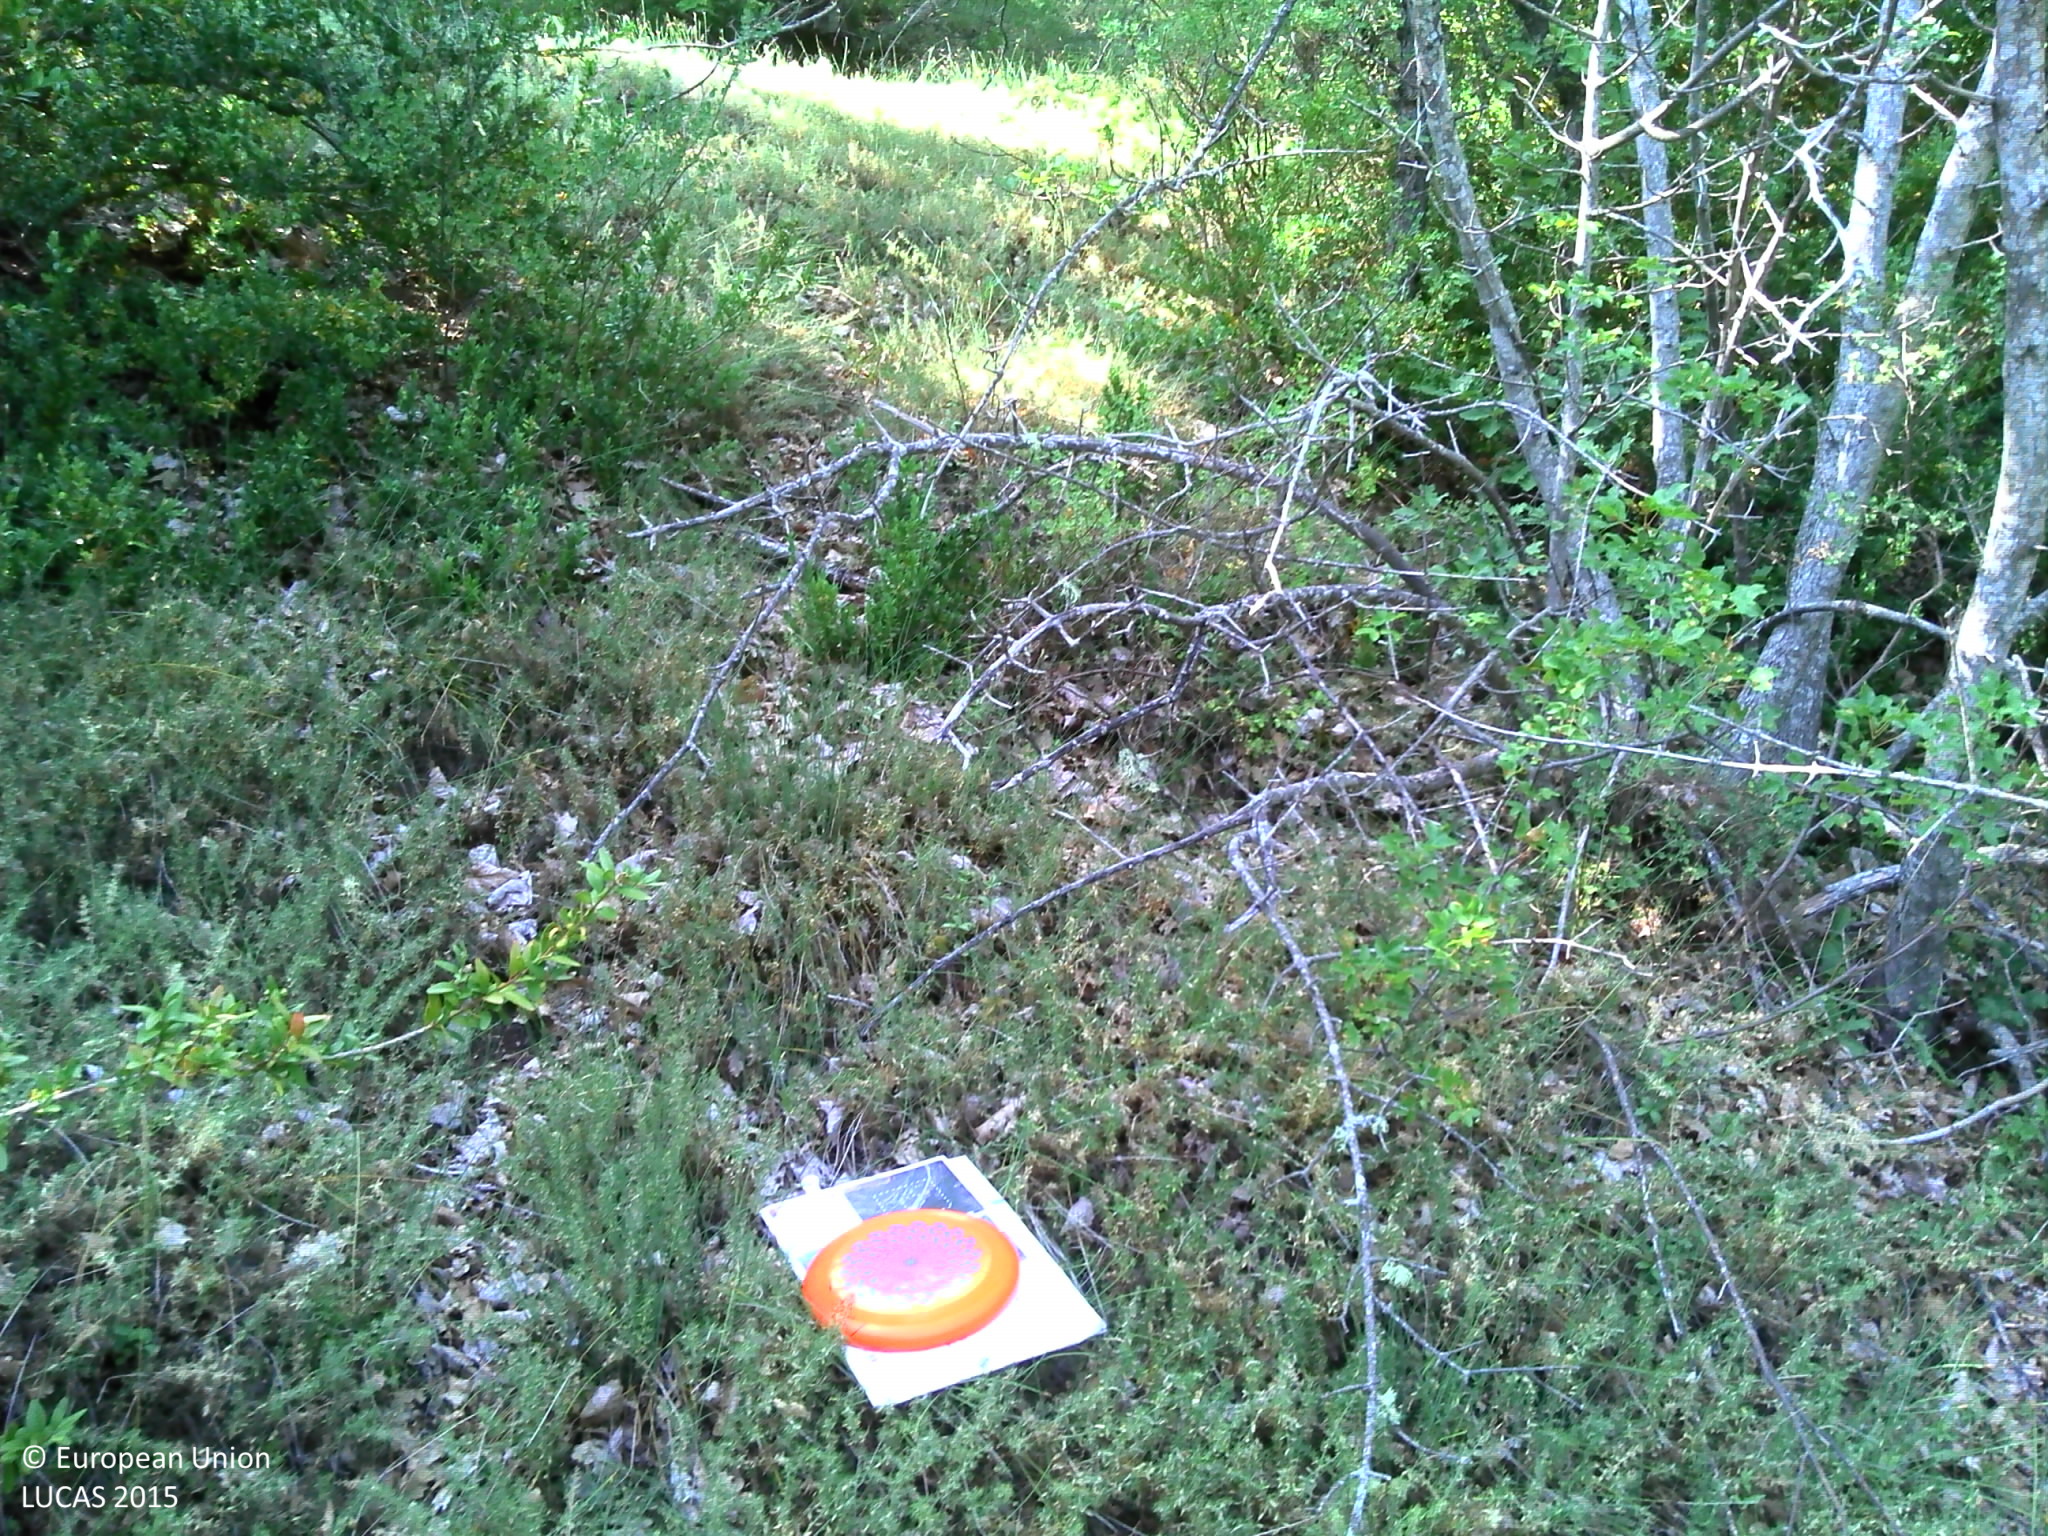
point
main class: Woodland
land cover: Broadleaved woodland
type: acidophilous oak and oak-birch forest
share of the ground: > 75 %
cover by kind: broadleaved forest trees 40 %, shrubs 20 %, herbaceous plants 20 %, unconsolidated bare surface 10 %, coniferous forest trees 5 %, lichens and mosses 5 %
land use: Semi-natural and natural areas not in use
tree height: > 5 m
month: July
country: FR
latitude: 44.0320
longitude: 5.4040
